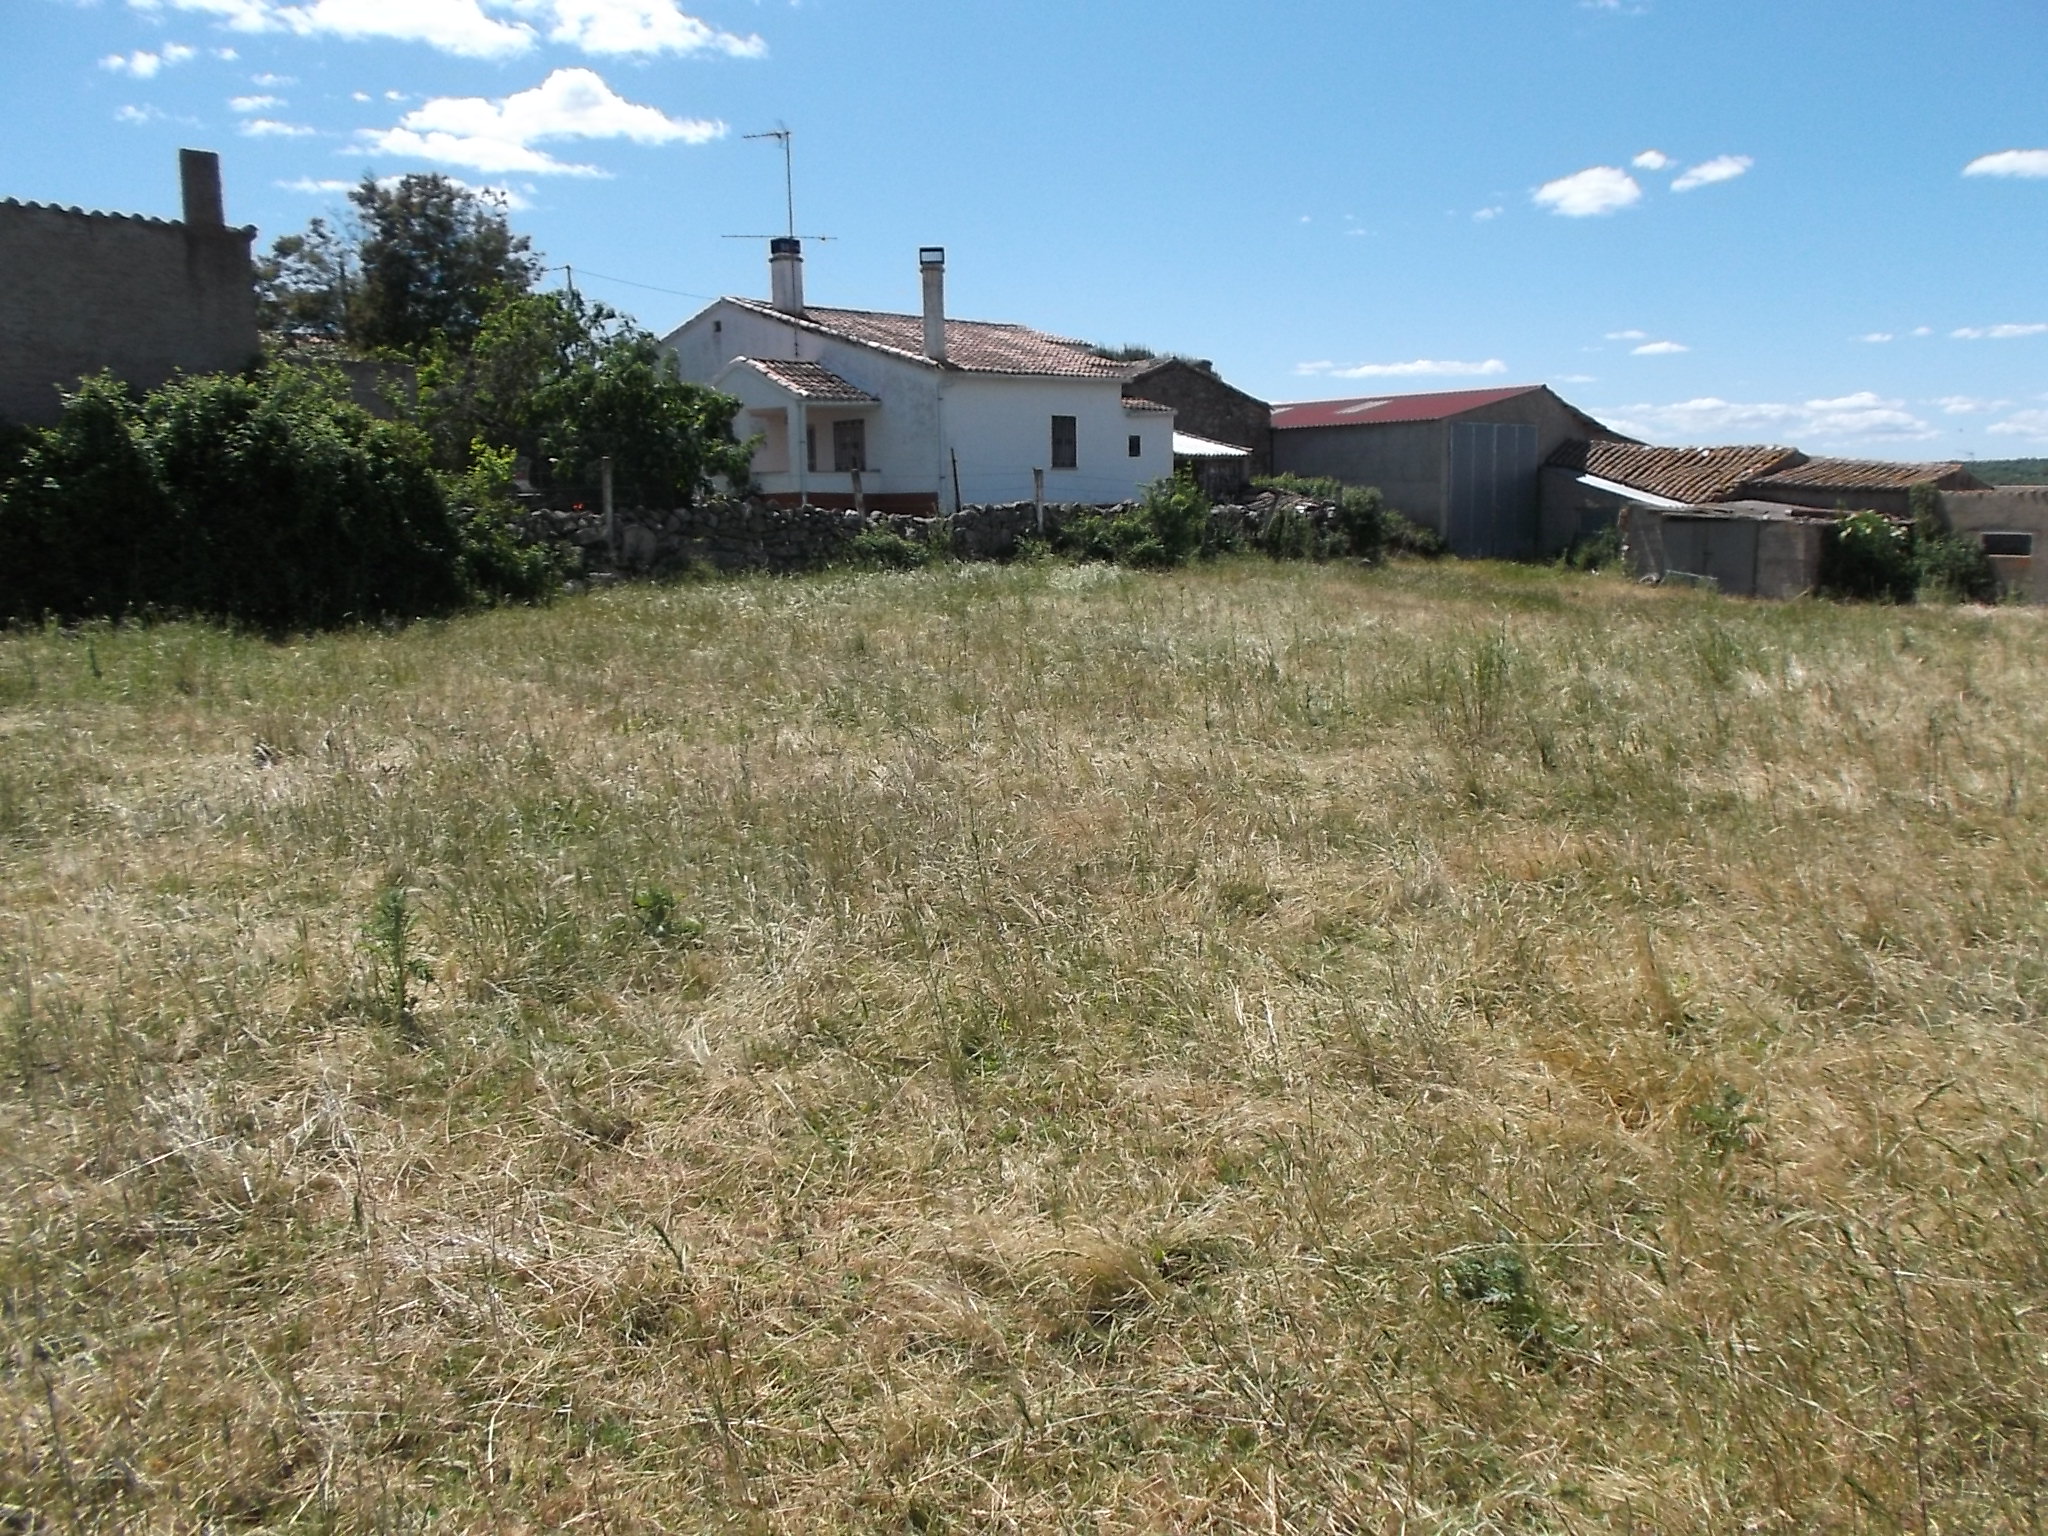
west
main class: Grassland
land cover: Grassland without tree/shrub cover
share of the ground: > 75 %
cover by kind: herbaceous plants 100 %
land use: Agriculture (excluding fallow land and kitchen gardens)
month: May
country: ES
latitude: 40.9619
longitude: -6.2604
